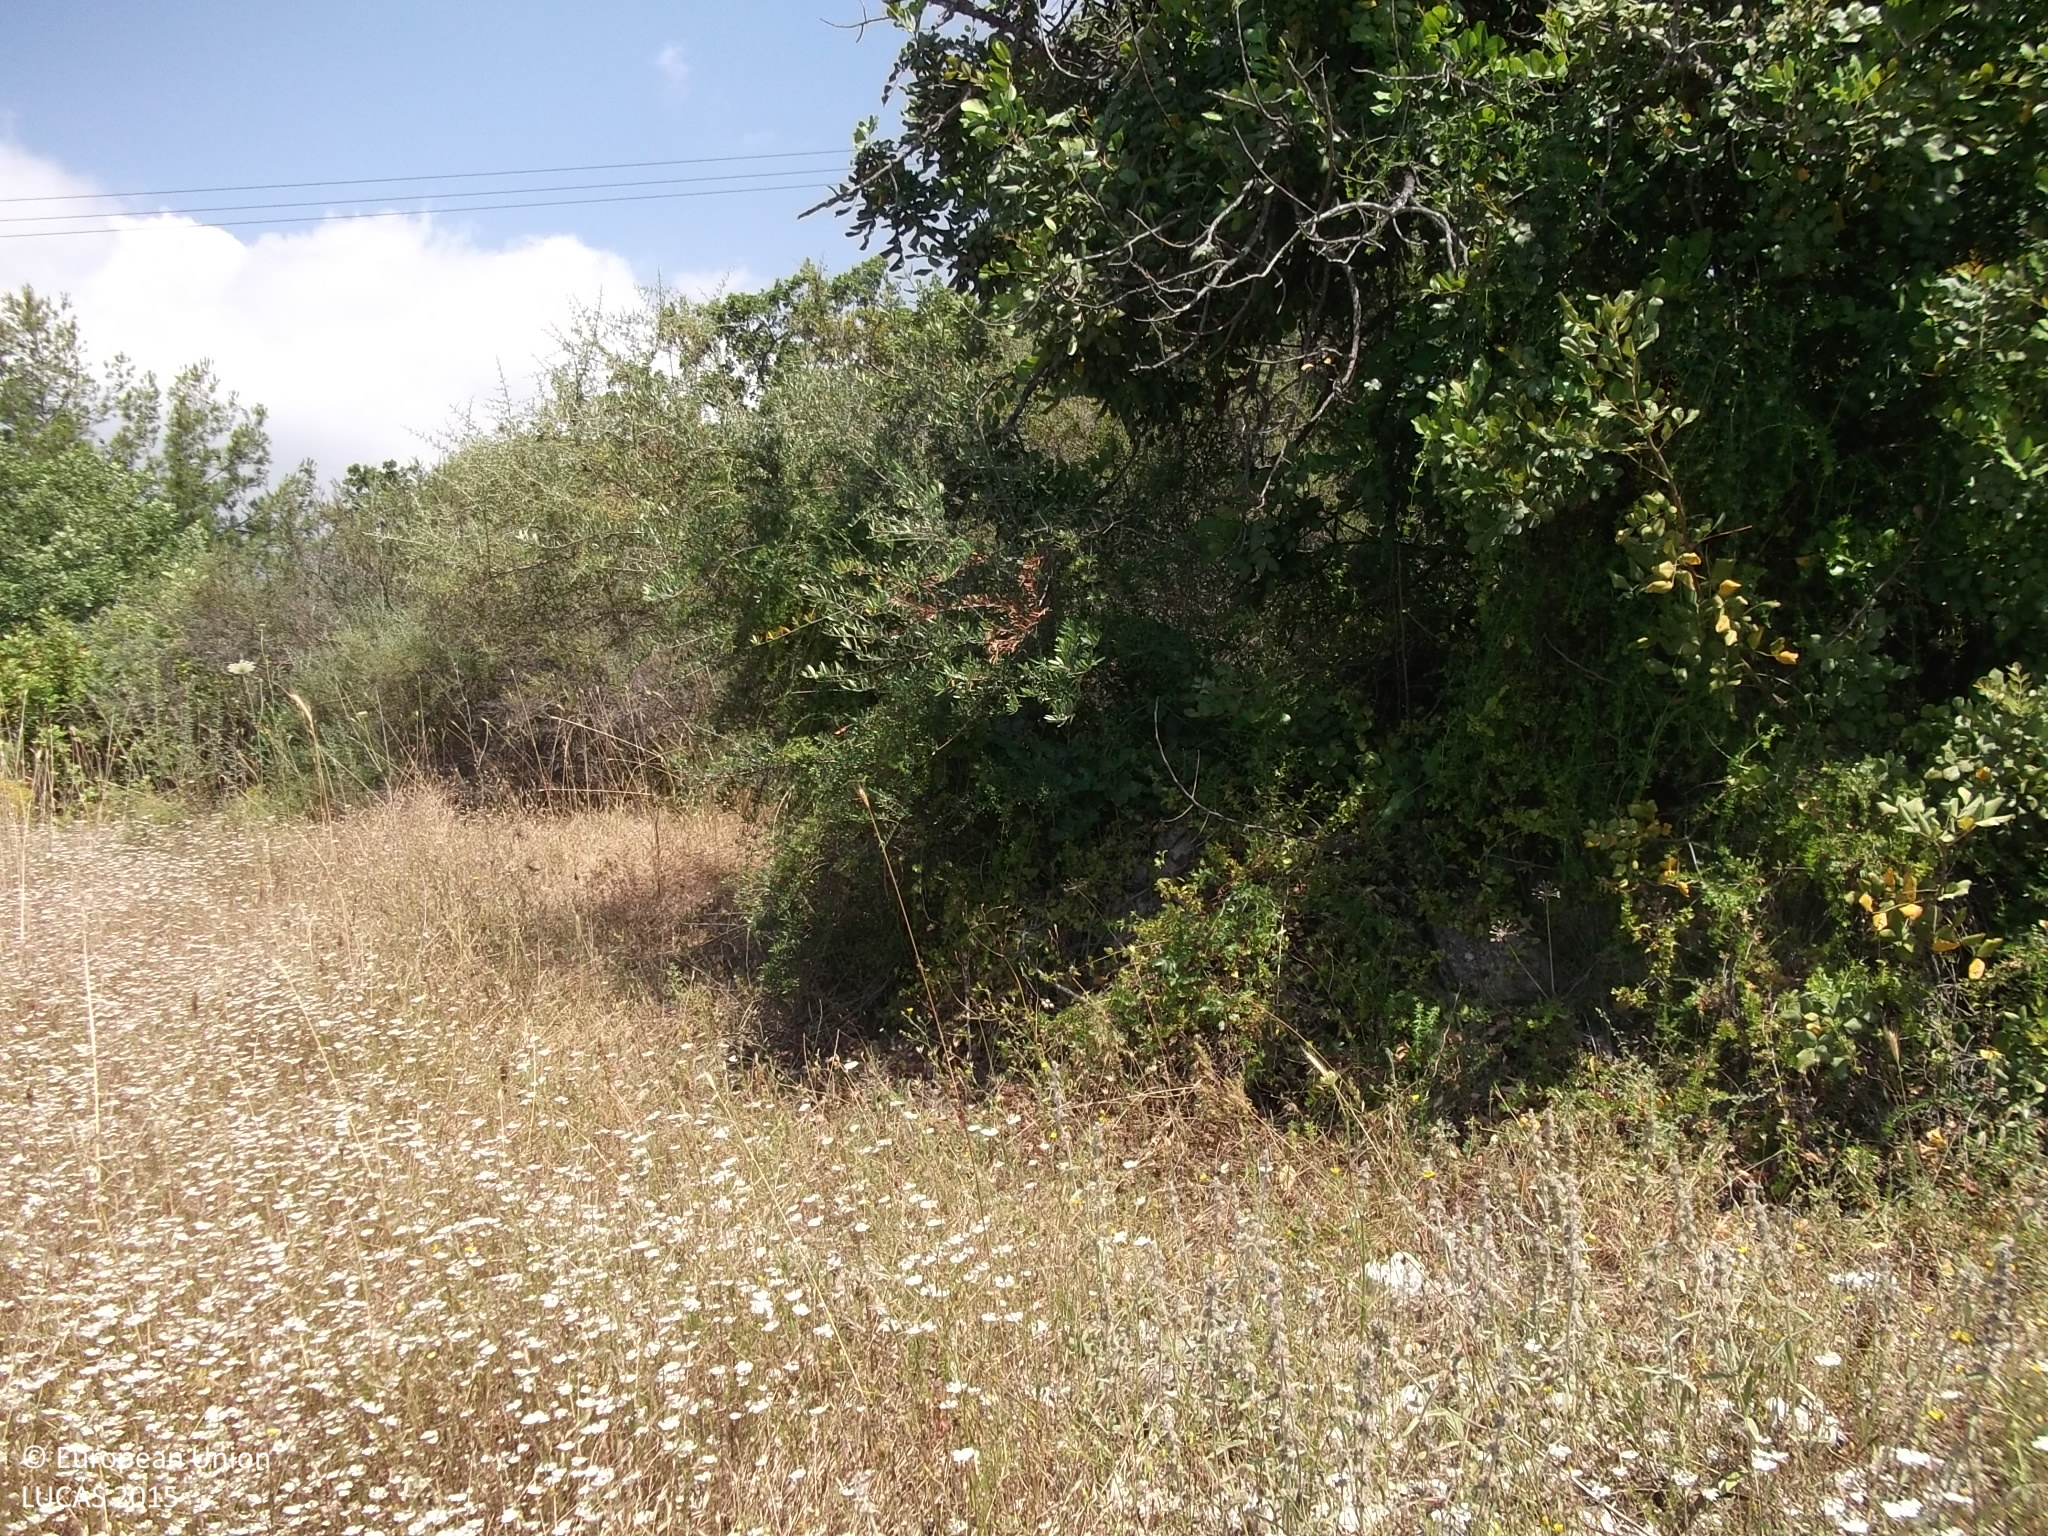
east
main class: Grassland
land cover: Grassland without tree/shrub cover
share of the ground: > 75 %
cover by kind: herbaceous plants 100 %
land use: Semi-natural and natural areas not in use
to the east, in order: Grassland without tree/shrub cover; Shrubland with sparse tree cover; Electric lines; Olive groves; Lines of trees; Spontaneously vegetated surfaces; Abandoned hedges; Mixed cereals for fodder; Electric lines; Other bare soil; Abandoned hedges; Other bare soil; Other citrus fruit; Olive groves; Mixed cereals for fodder
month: June
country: CY
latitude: 34.9966
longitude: 32.4945
